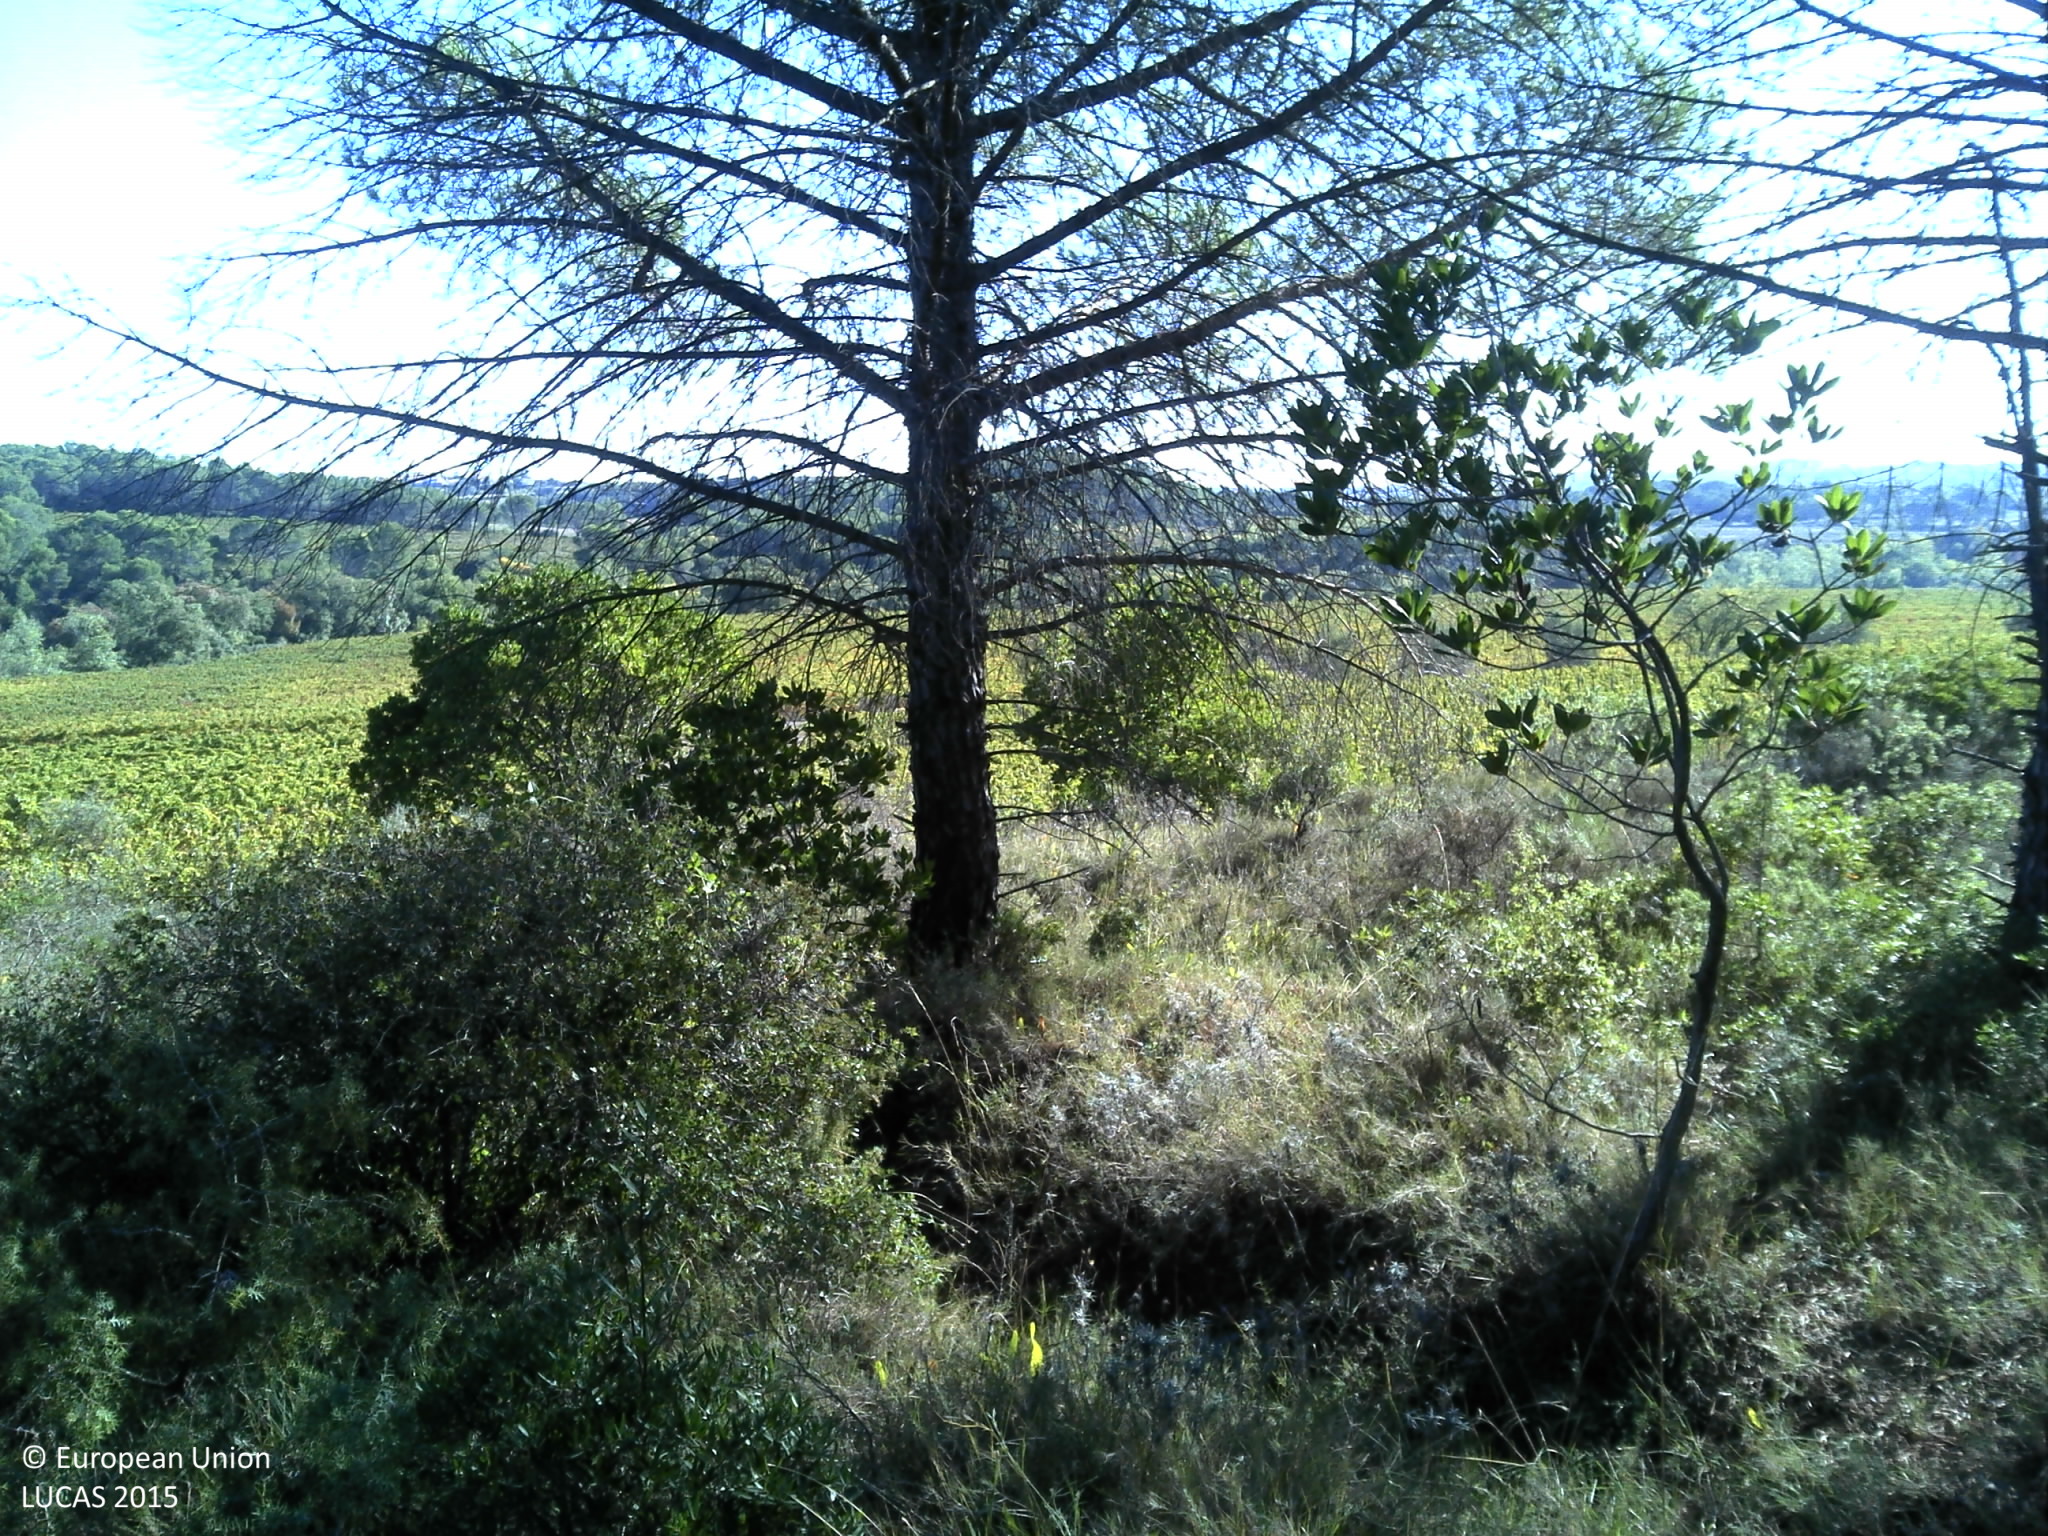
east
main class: Woodland
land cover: Pine dominated mixed woodland
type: coniferous forest of the mediterranean region
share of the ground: > 75 %
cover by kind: coniferous forest trees 45 %, broadleaved forest trees 30 %, shrubs 15 %, herbaceous plants 10 %
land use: Semi-natural and natural areas not in use
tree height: > 5 m
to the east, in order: Pine dominated mixed woodland; Tracks; Rock outcrops; Grass margins; Vineyards; Lines of trees; Grass margins; Vineyards
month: October
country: FR
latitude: 43.4903
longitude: 3.1458
